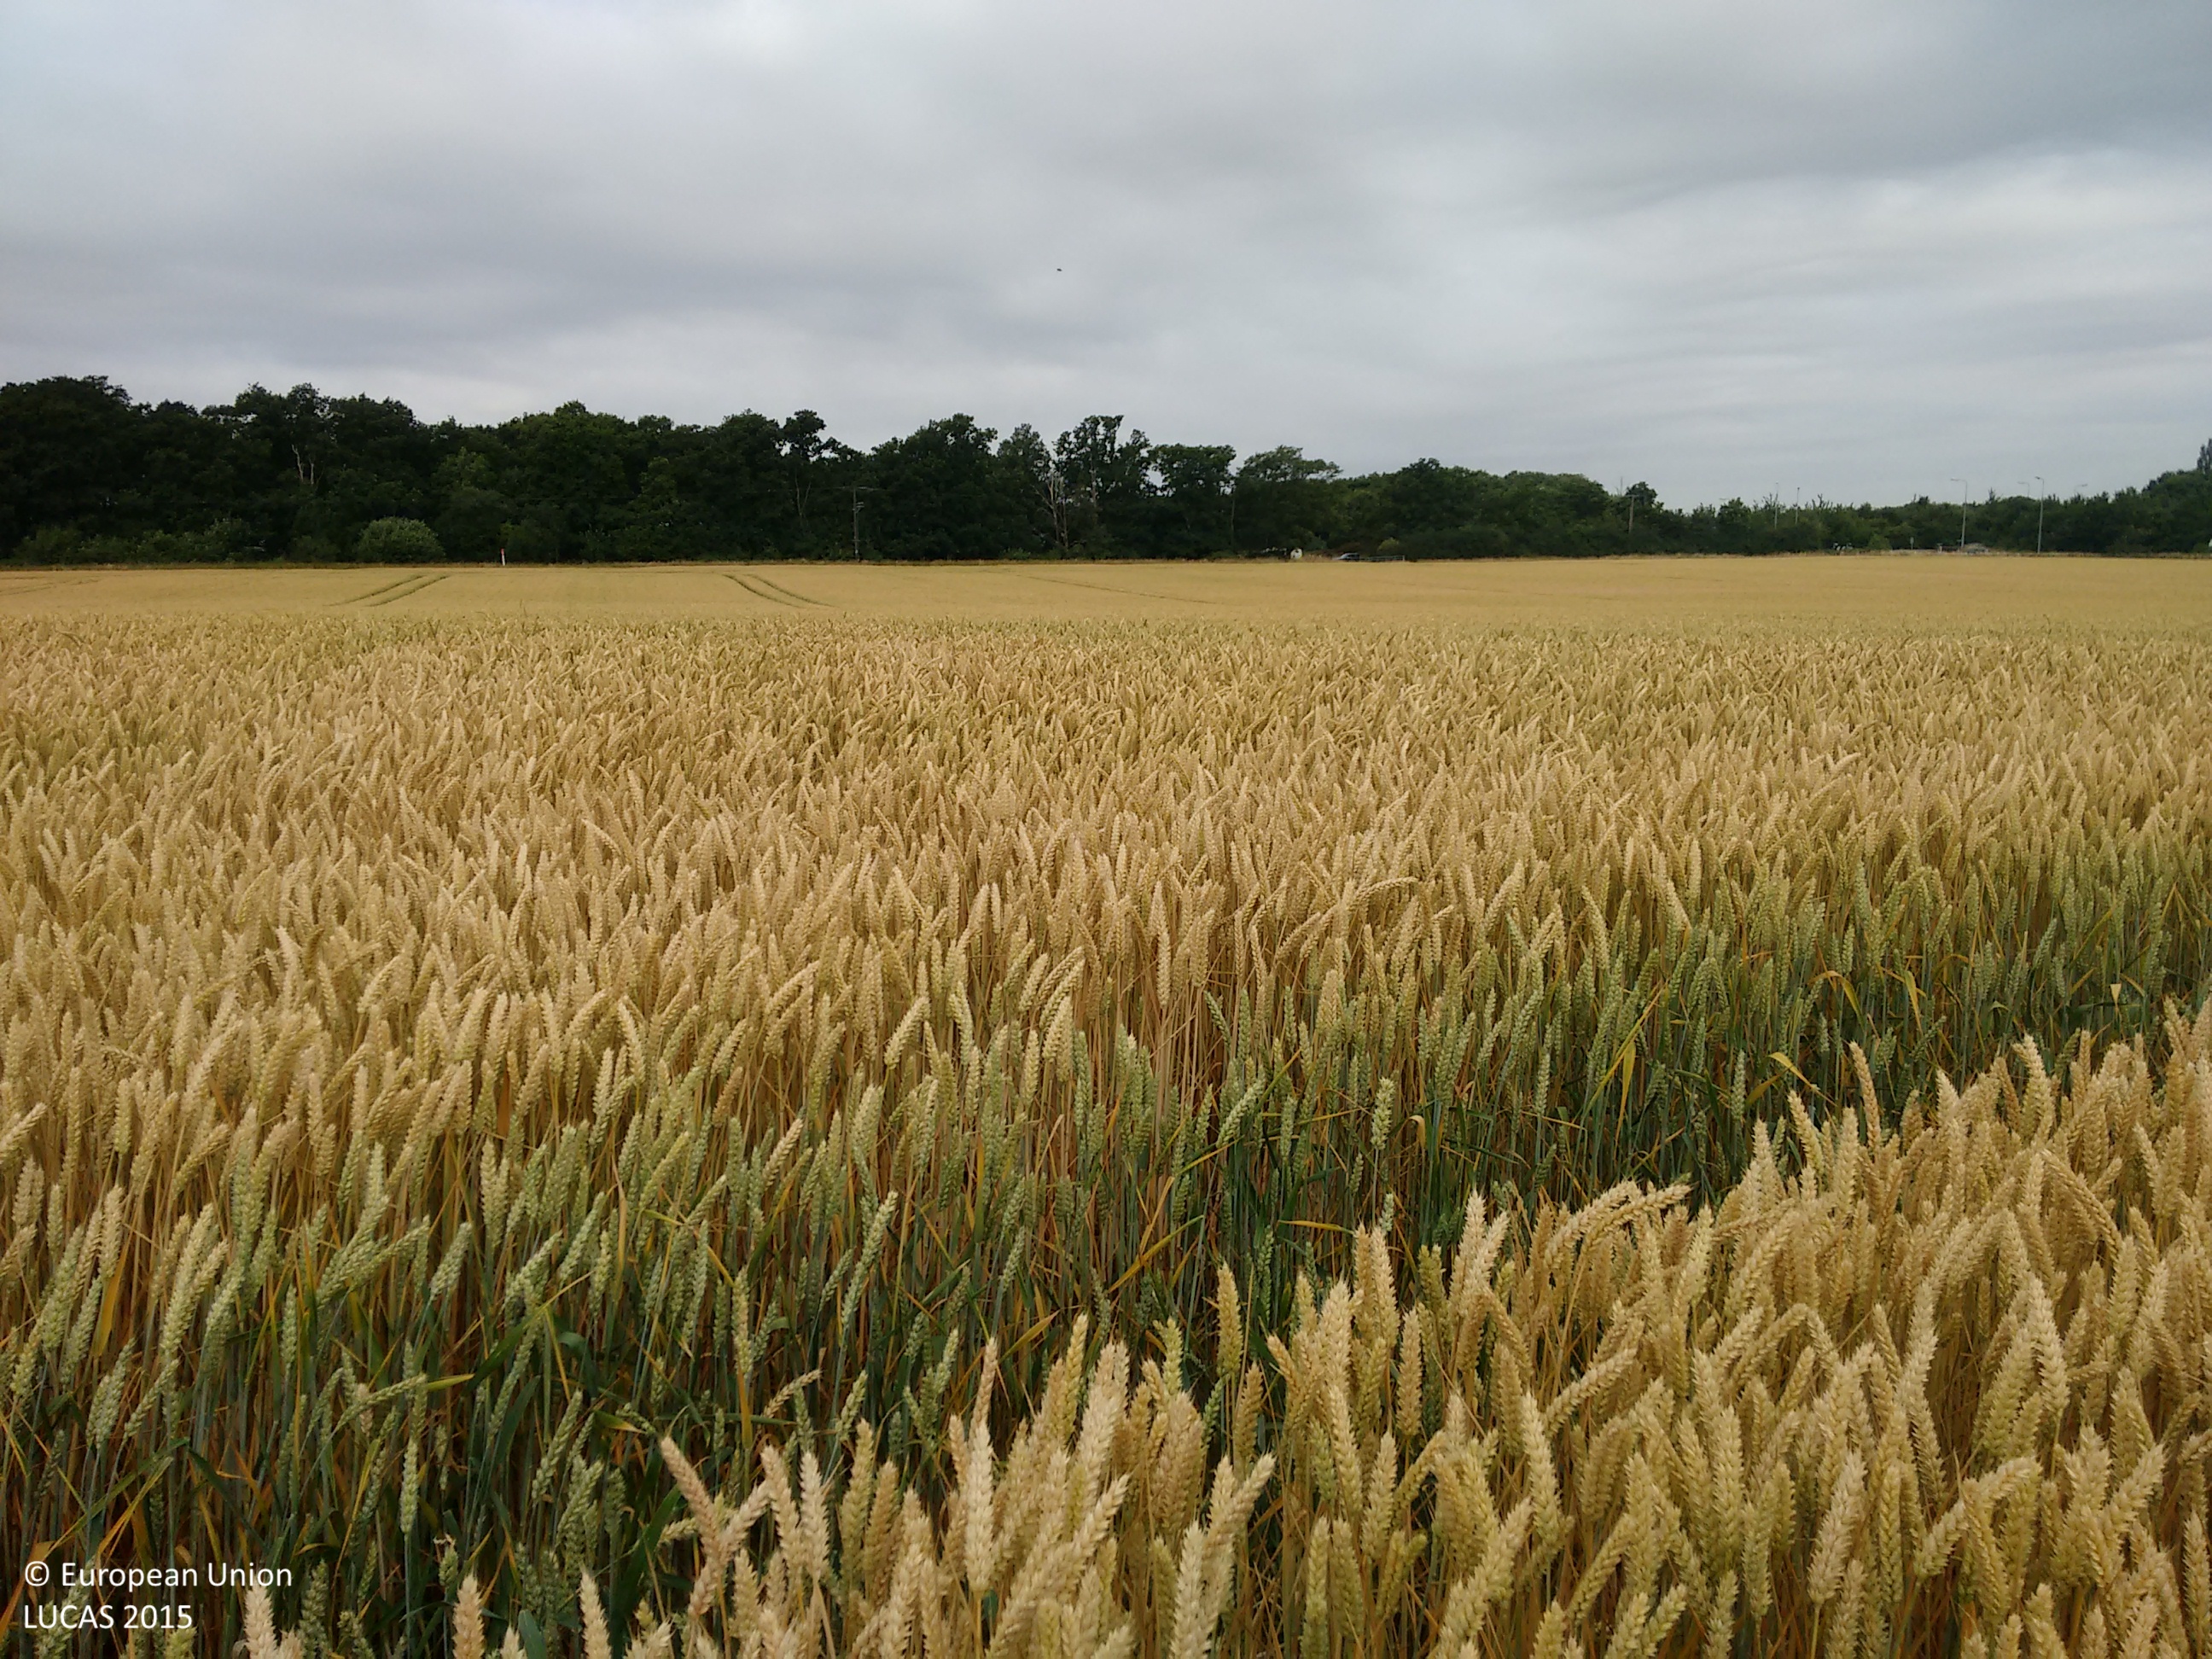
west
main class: Cropland
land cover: Common wheat
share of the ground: > 75 %
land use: Agriculture (excluding fallow land and kitchen gardens)
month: July
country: GB
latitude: 51.6854
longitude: 0.4687
